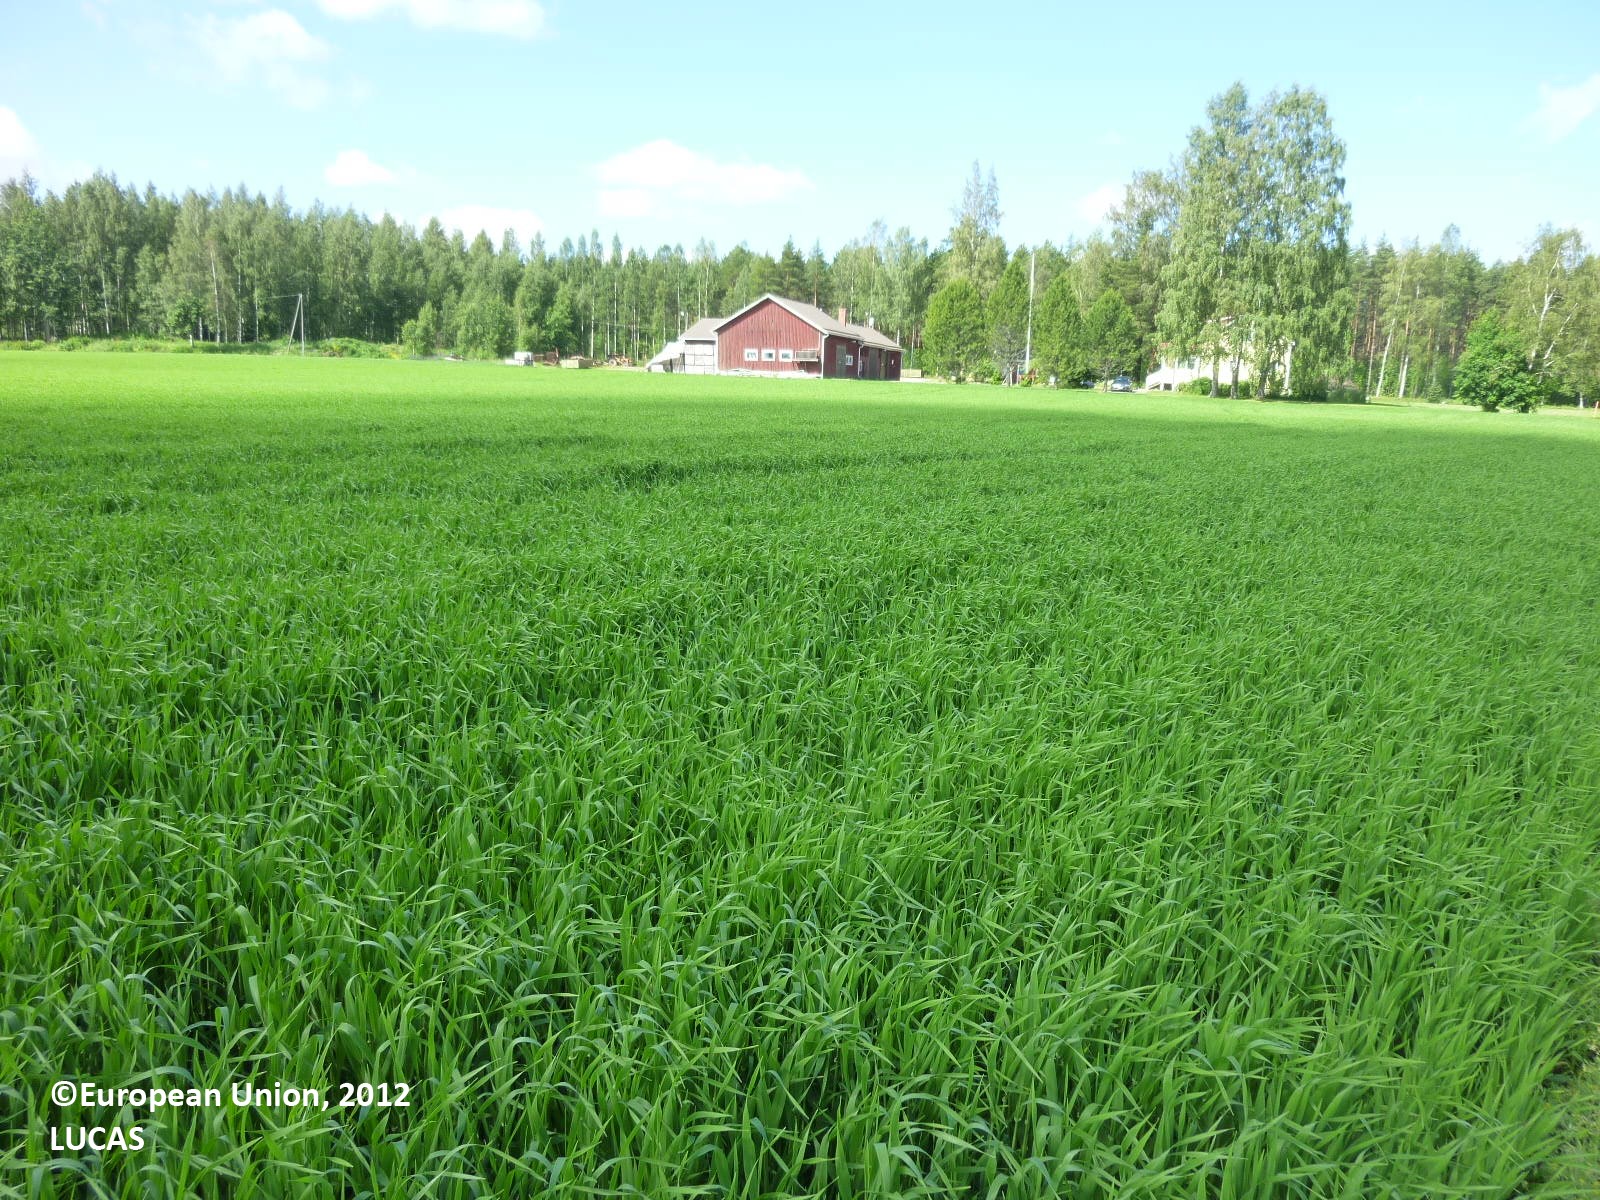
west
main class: Cropland
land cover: Barley
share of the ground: > 75 %
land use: Agriculture (excluding fallow land and kitchen gardens)
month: July
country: FI
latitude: 61.2910
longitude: 22.2096
